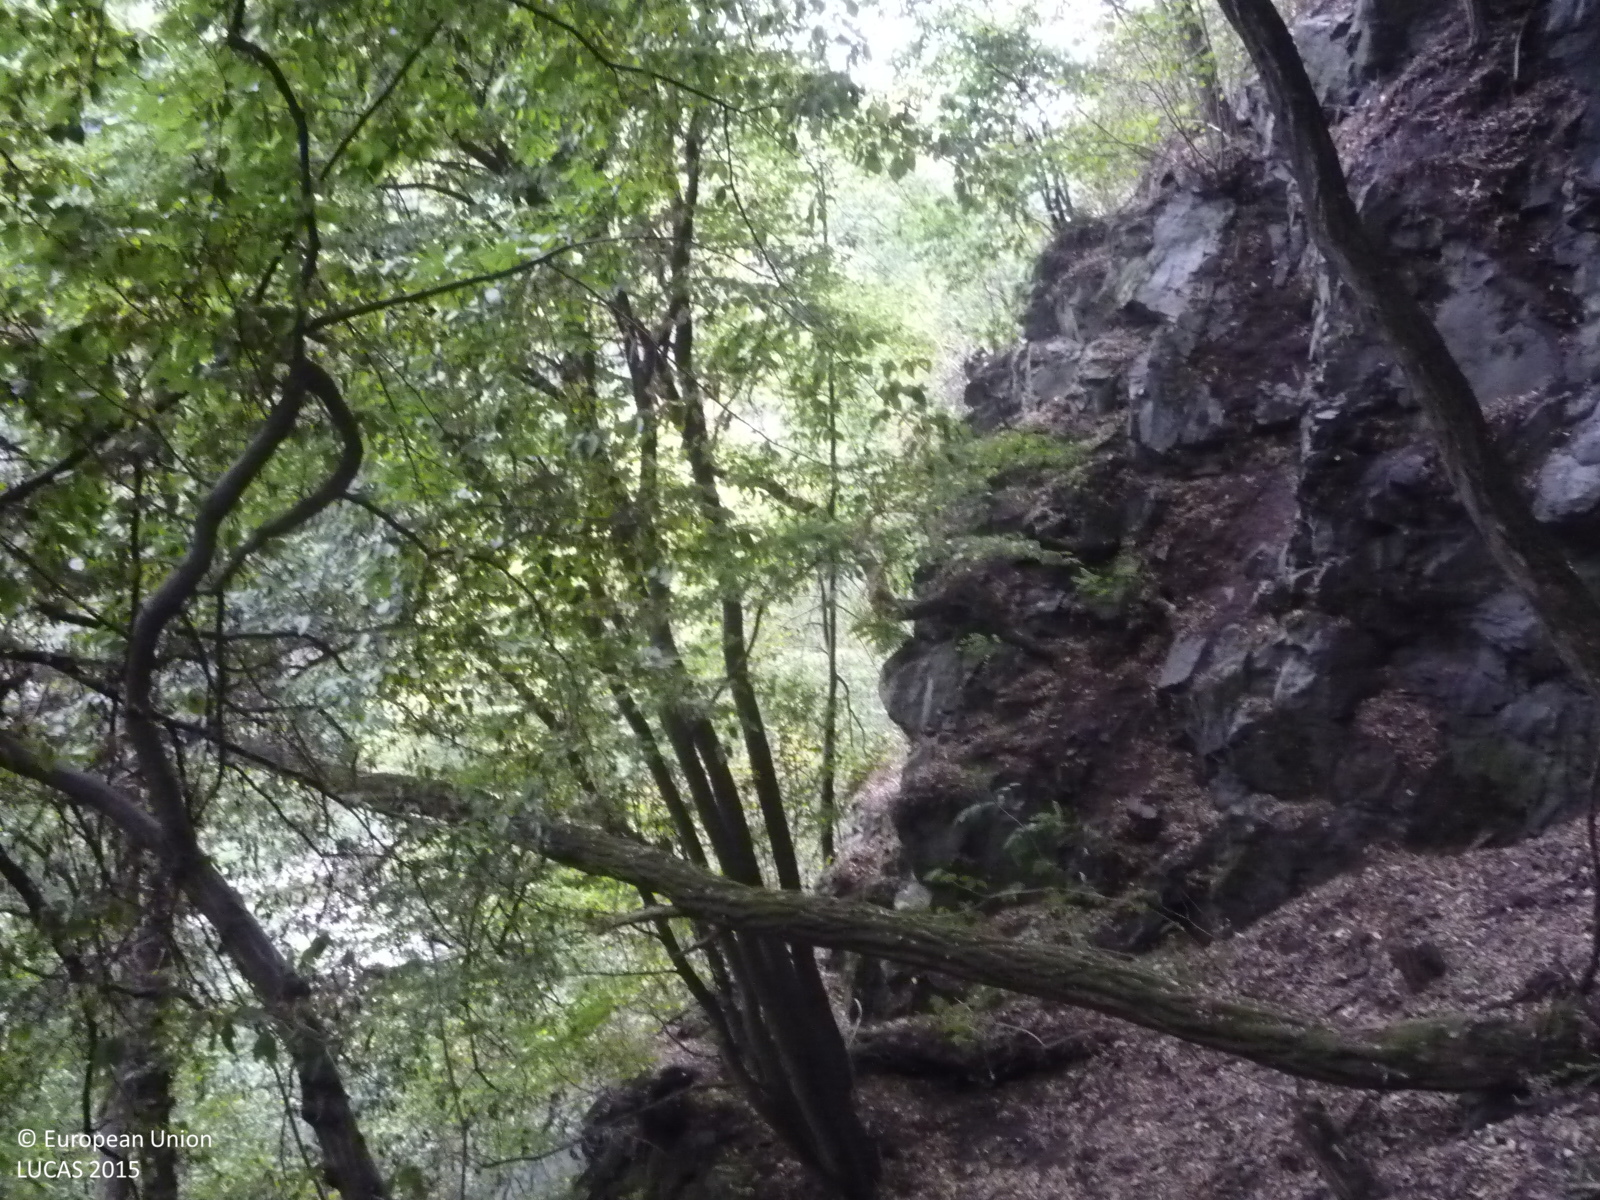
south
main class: Woodland
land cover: Broadleaved woodland
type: mesophytic deciduous forest
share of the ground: > 75 %
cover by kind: broadleaved forest trees 95 %, unconsolidated bare surface 5 %
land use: Forestry
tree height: > 5 m
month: August
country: CZ
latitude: 49.8626
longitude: 14.4671
